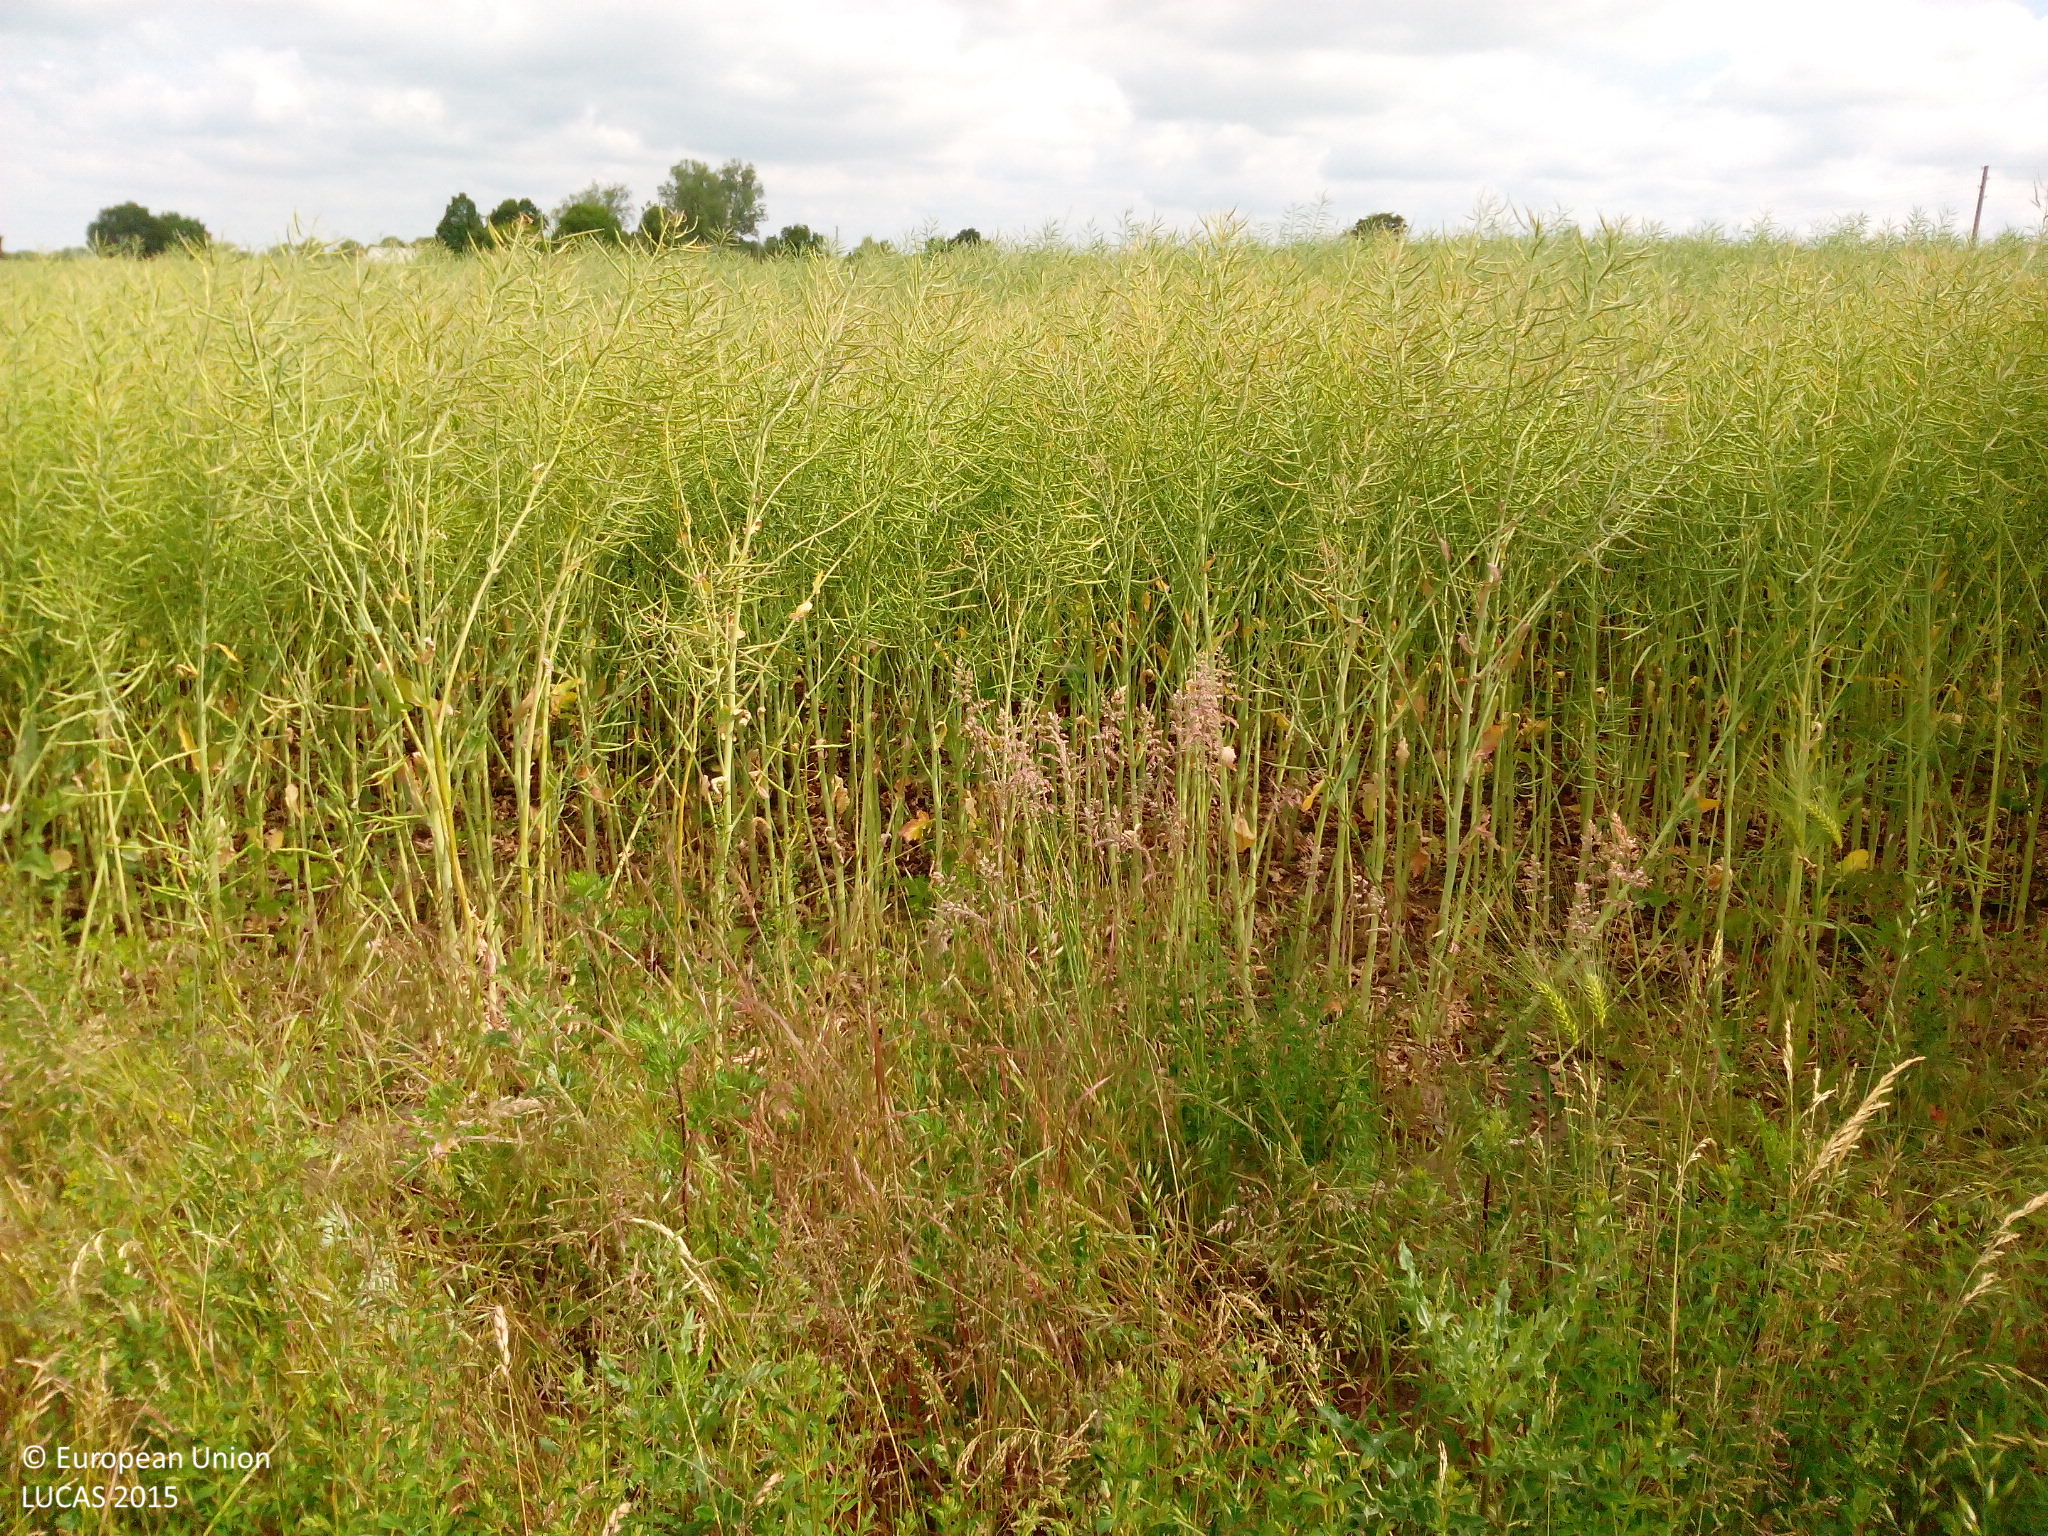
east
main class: Grassland
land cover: Grassland without tree/shrub cover
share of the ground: > 75 %
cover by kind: herbaceous plants 100 %
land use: Agriculture (excluding fallow land and kitchen gardens)
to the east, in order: Grassland without tree/shrub cover; Fences; Grassland without tree/shrub cover; Inland fresh water bodies; Grassland without tree/shrub cover; Broadleaved woodland; Fences; Tracks; Electric lines; Abandoned hedges; Maize
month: June
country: DE
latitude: 53.7566
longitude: 11.0763
